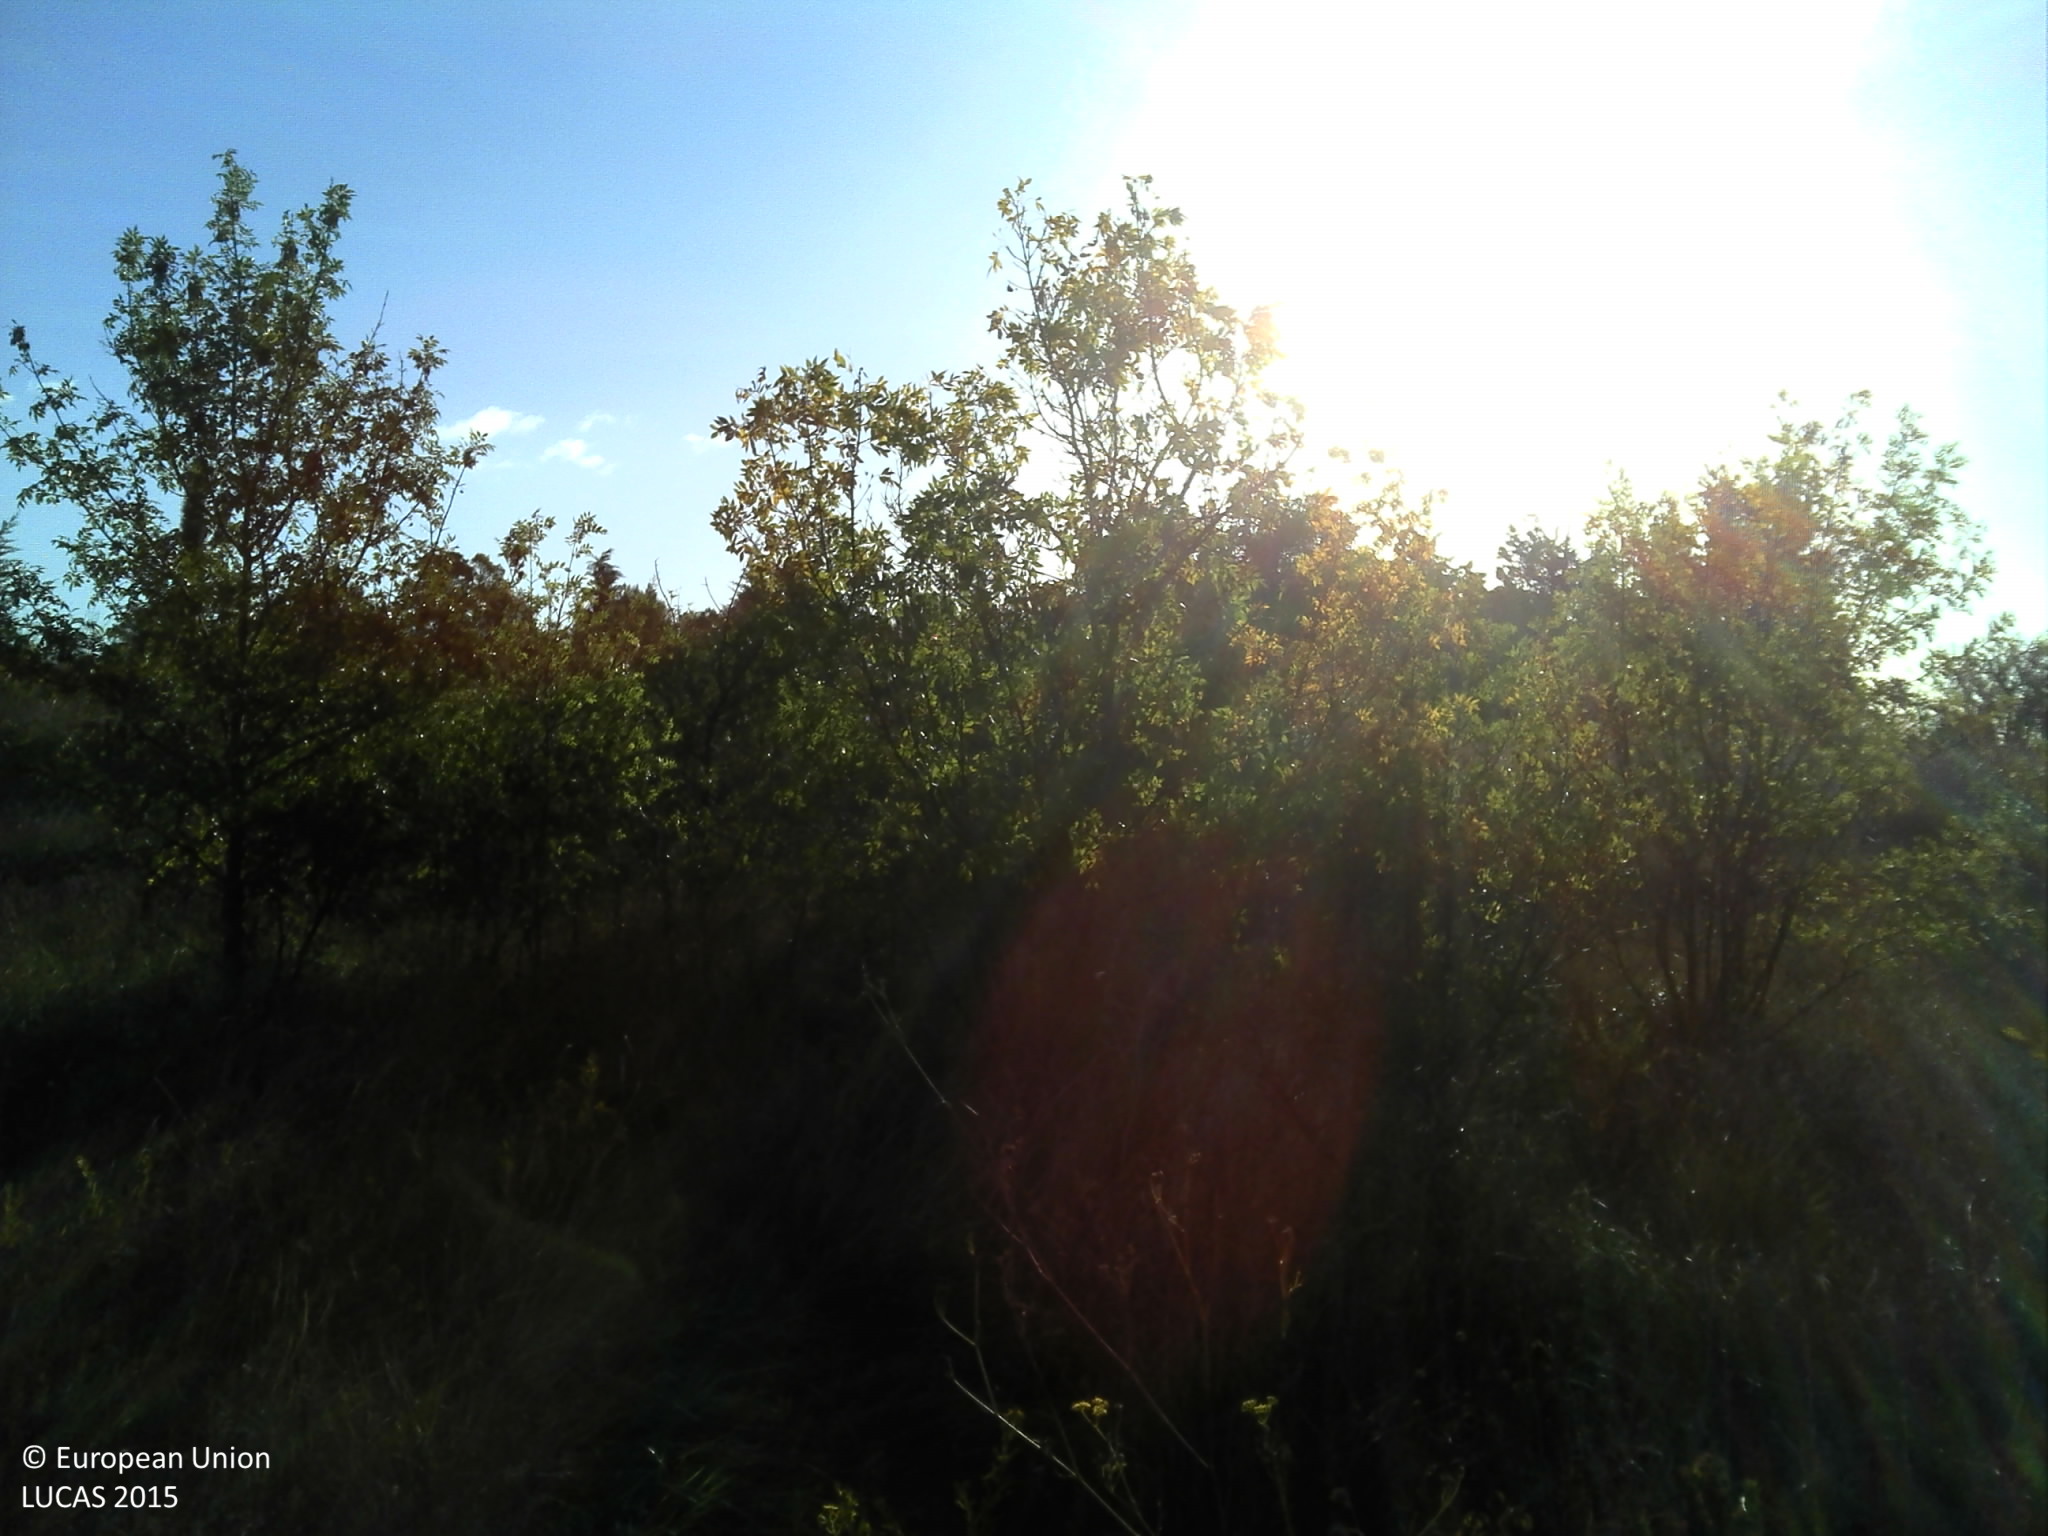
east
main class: Shrubland
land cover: Shrubland with sparse tree cover
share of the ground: > 75 %
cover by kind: herbaceous plants 75 %, shrubs 20 %, broadleaved forest trees 5 %
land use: Semi-natural and natural areas not in use
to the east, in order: Shrubland with sparse tree cover; Spruce dominated coniferous woodland; Shrubland with sparse tree cover; Grassland without tree/shrub cover; Pine dominated coniferous woodland; Fences; Shrubland with sparse tree cover; Fences; Lines of trees; Paved roads, cycling and walking lanes; Lines of trees; Spontaneously vegetated surfaces; Vineyards
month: October
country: FR
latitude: 43.4471
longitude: 3.5964
